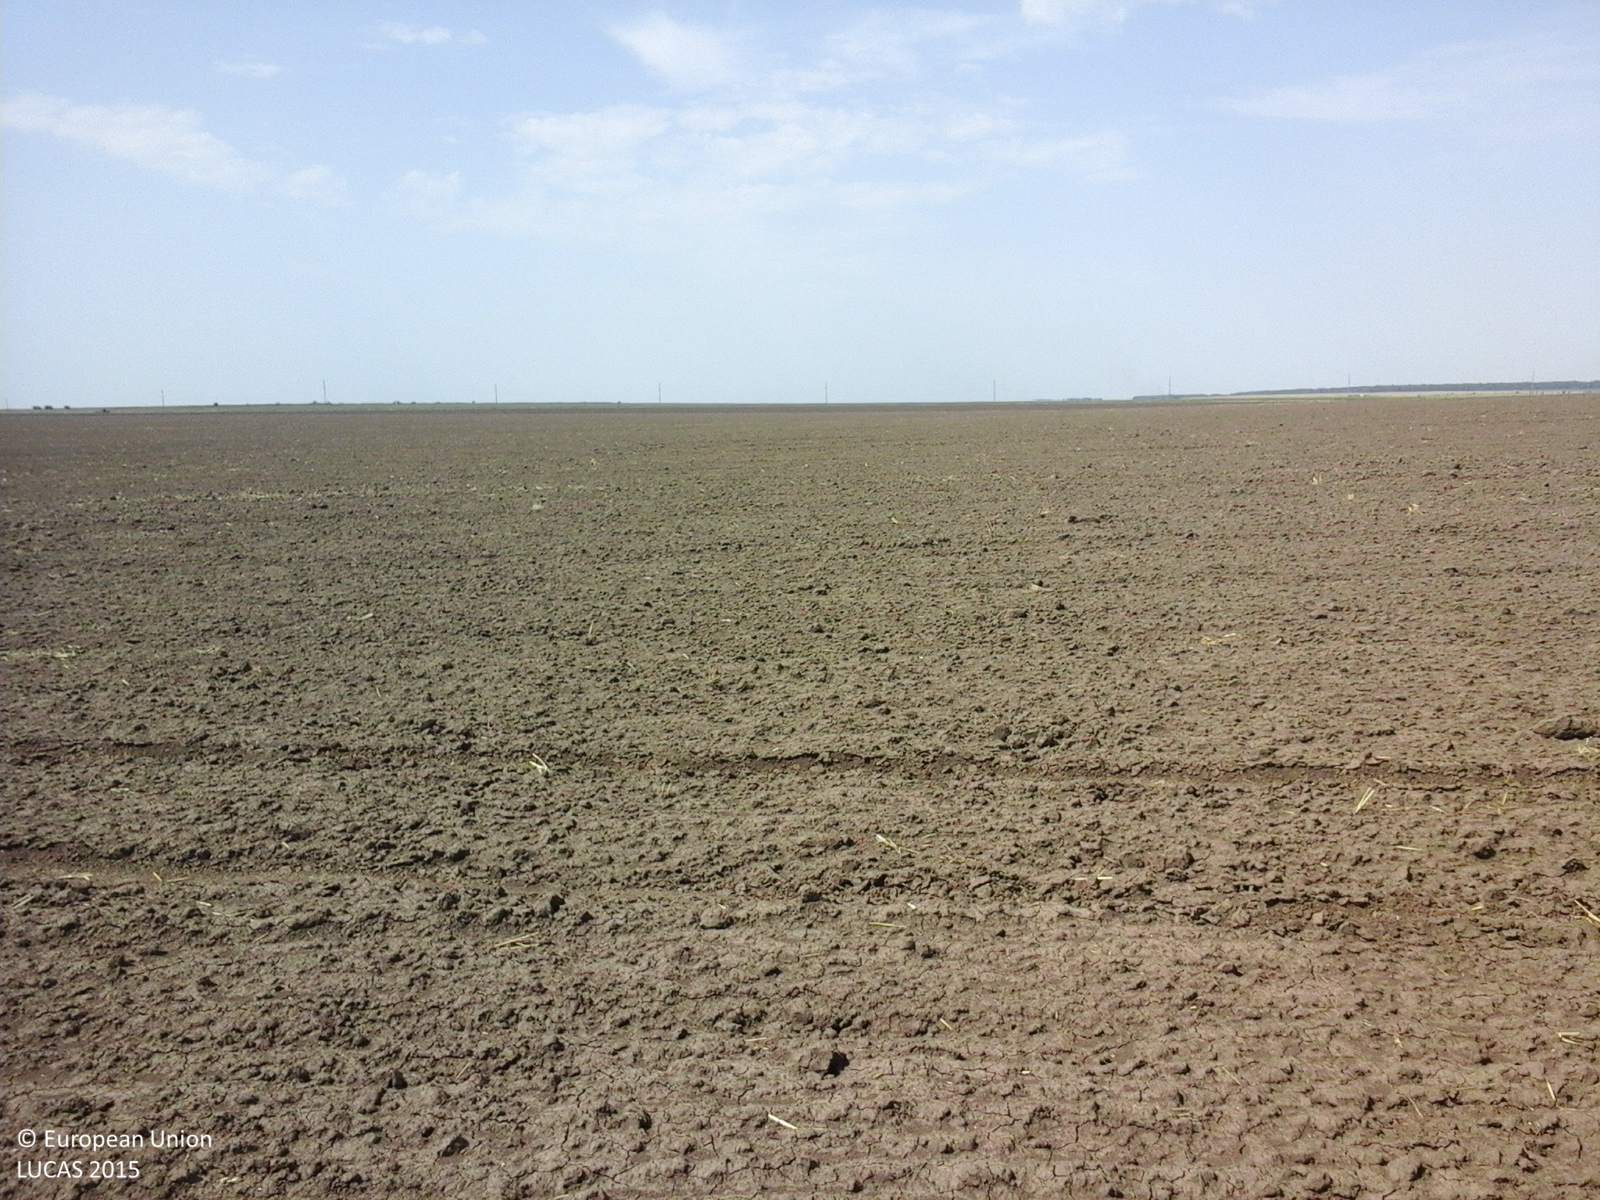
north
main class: Cropland
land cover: Common wheat
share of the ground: < 10 %
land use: Agriculture (excluding fallow land and kitchen gardens)
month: August
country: RO
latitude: 43.8836
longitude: 28.4227
